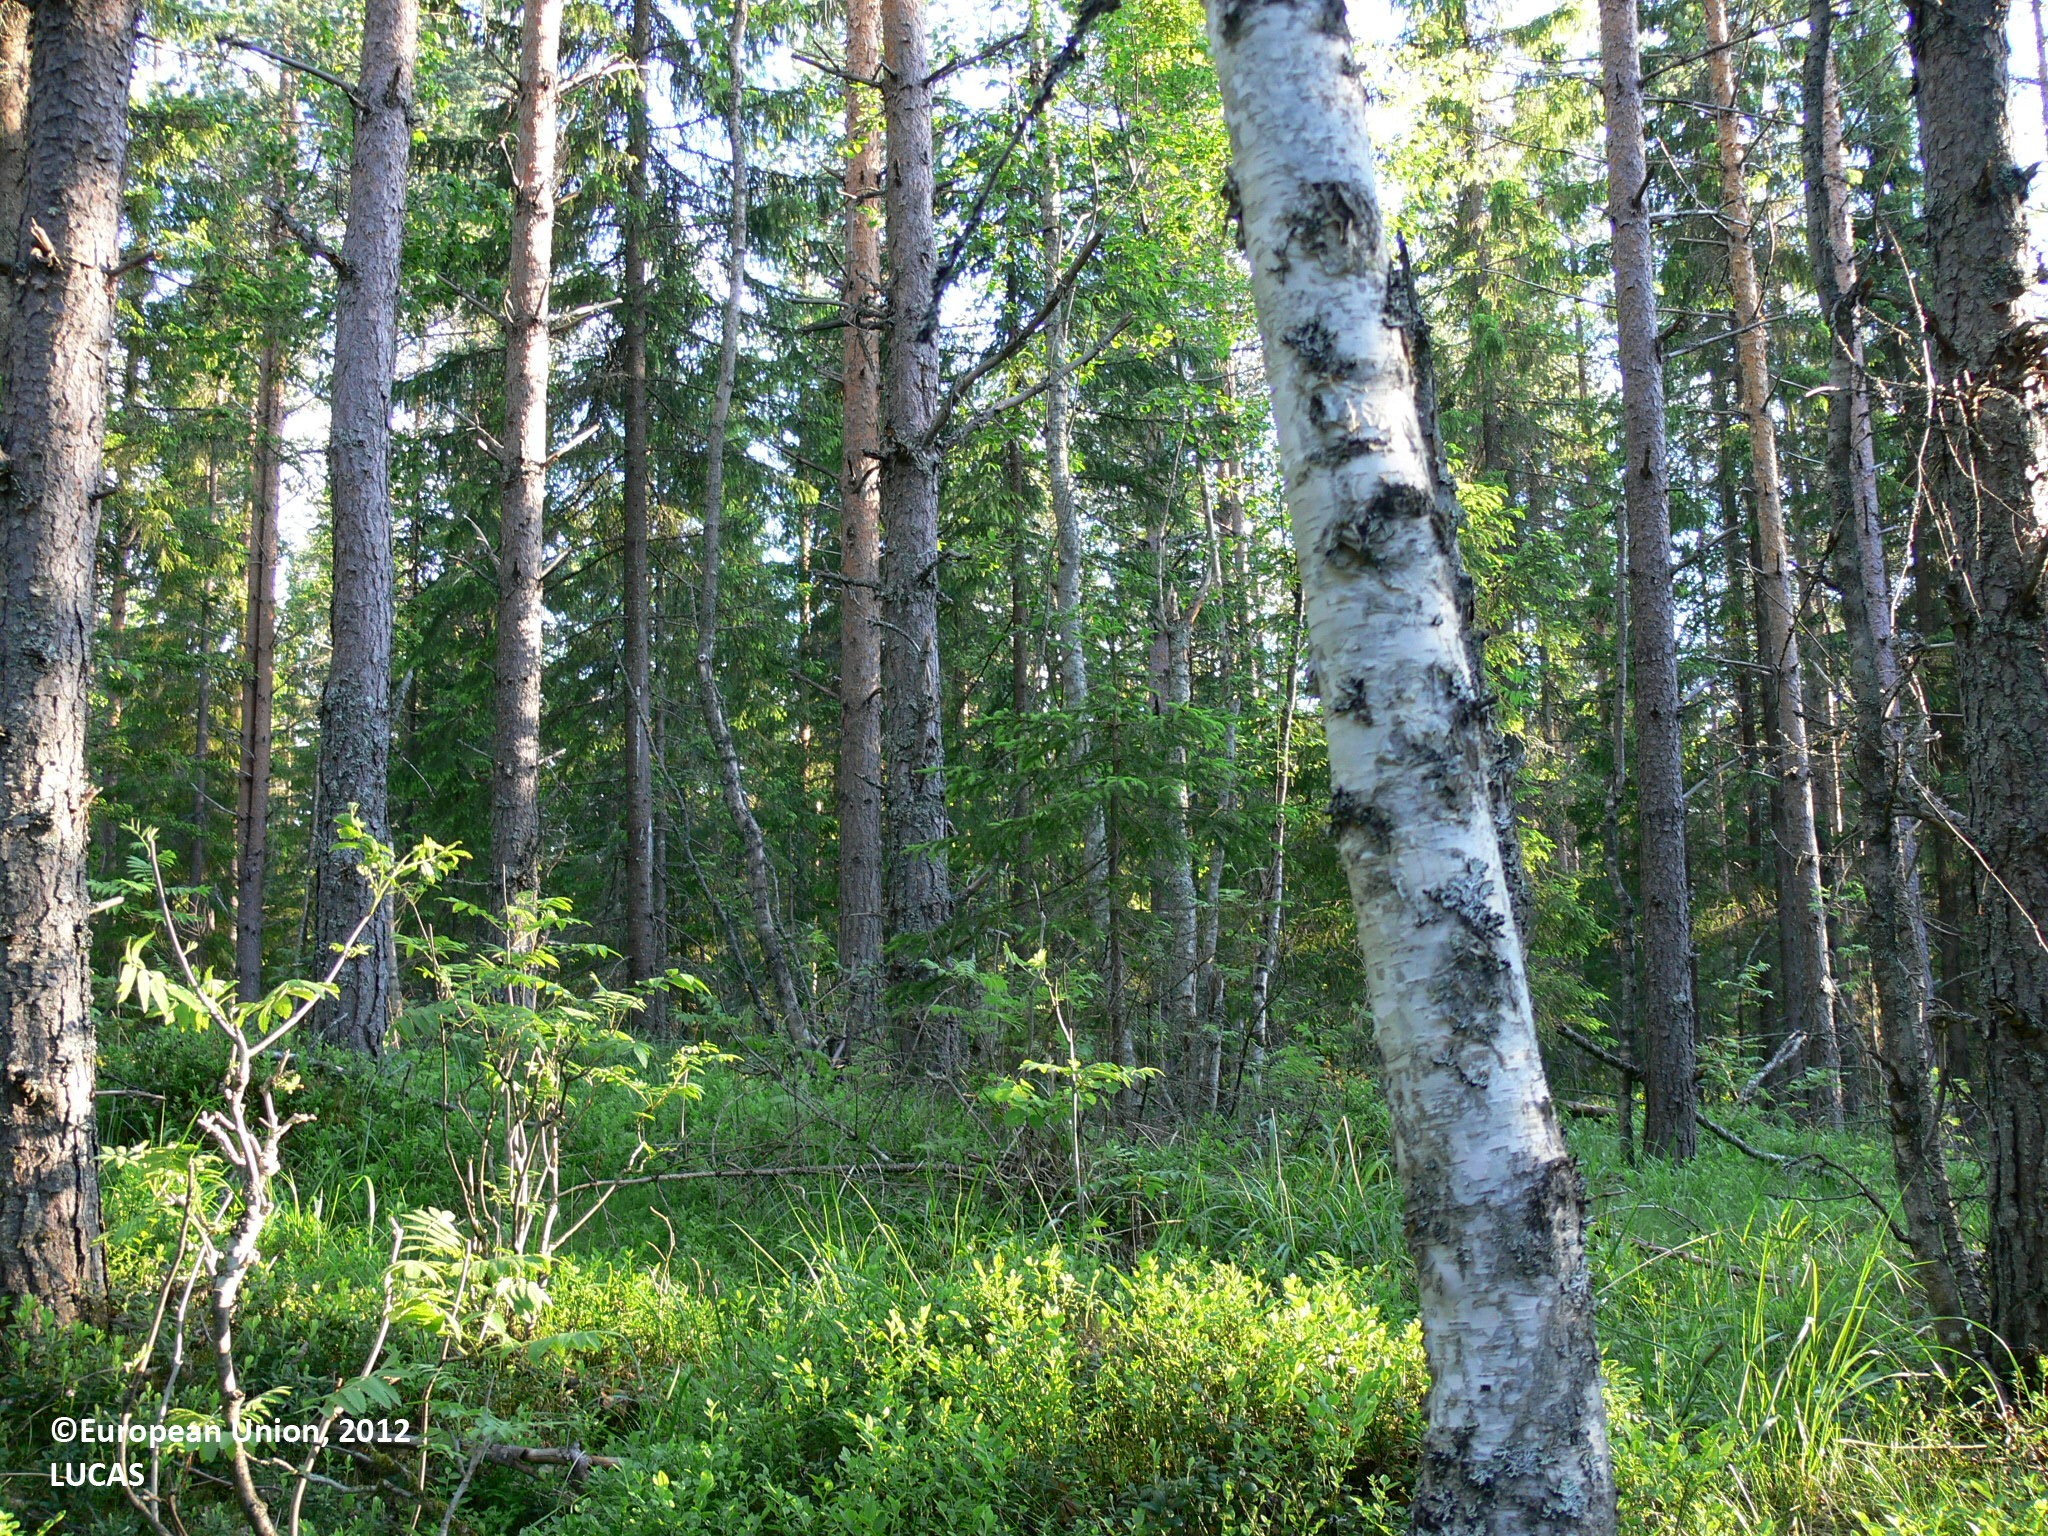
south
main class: Woodland
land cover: Other mixed woodland
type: boreal forest
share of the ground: > 75 %
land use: Forestry
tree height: > 5 m
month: June
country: FI
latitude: 62.2882
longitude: 30.5867
